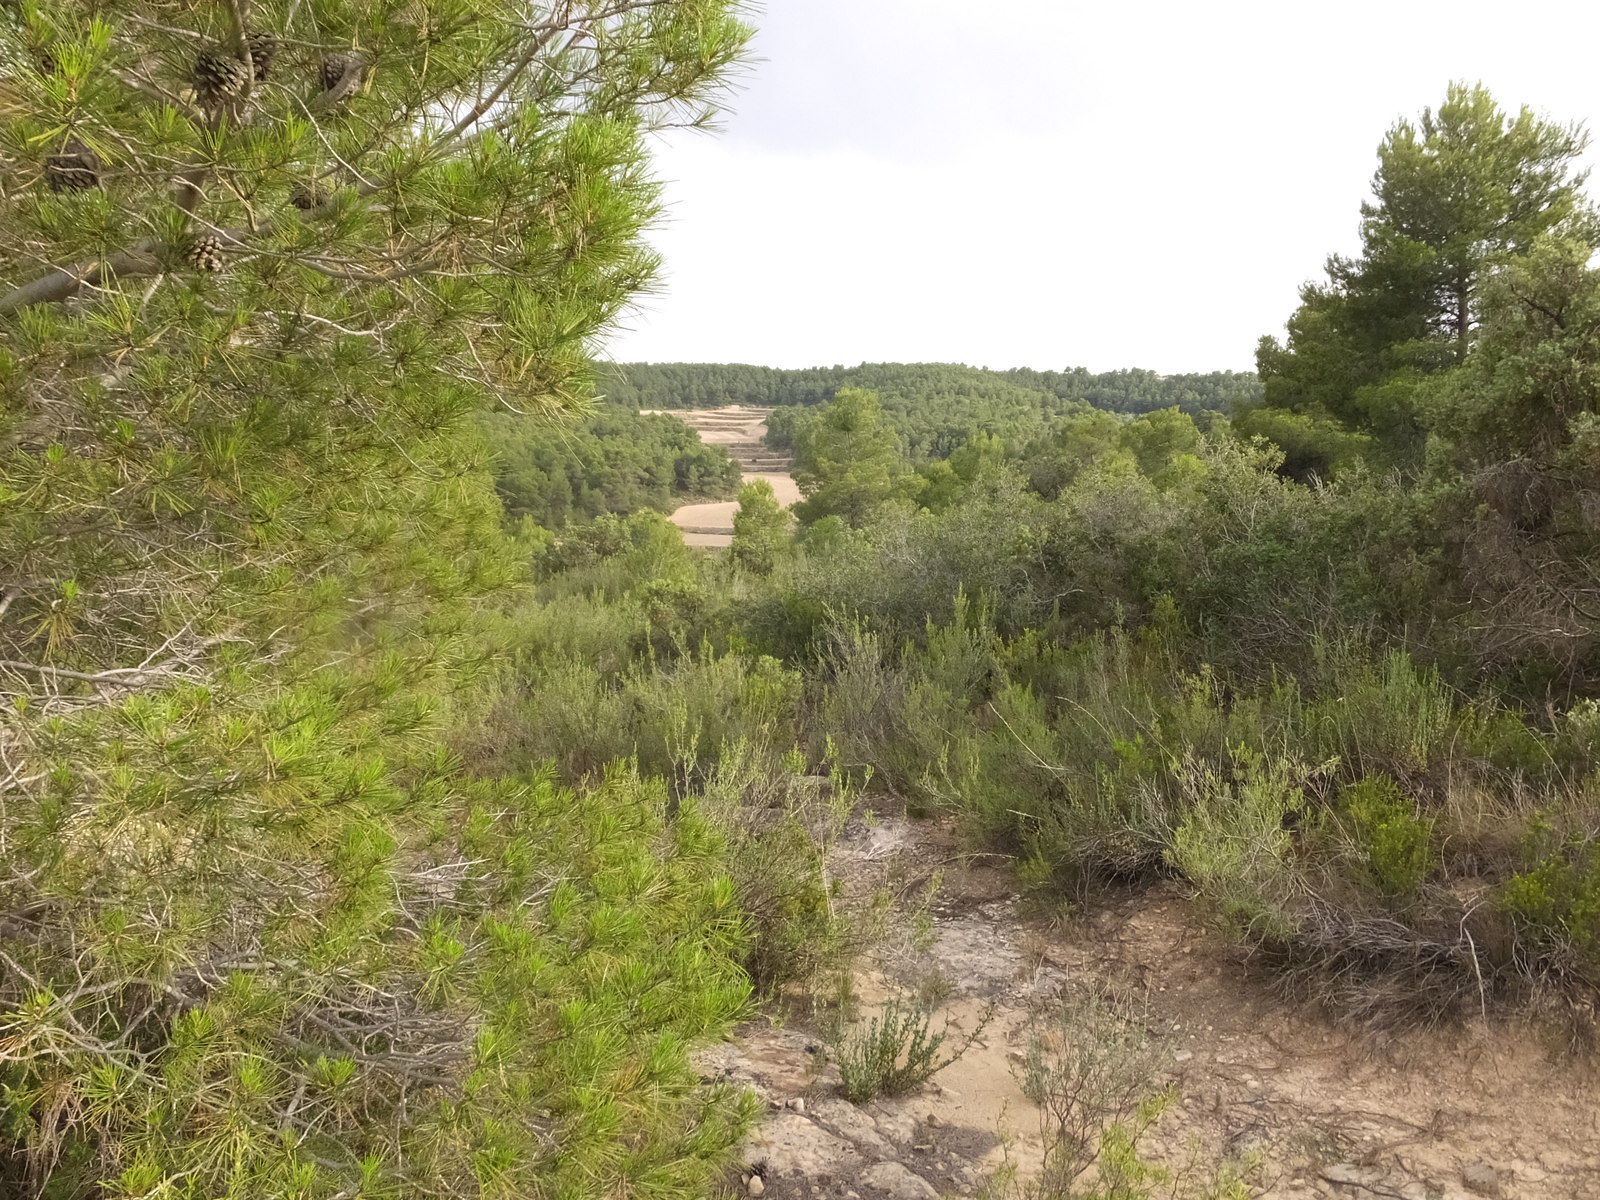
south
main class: Woodland
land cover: Pine dominated mixed woodland
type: coniferous forest of the mediterranean region
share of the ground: 50 - 75 %
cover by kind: coniferous forest trees 50 %, shrubs 30 %, broadleaved forest trees 20 %
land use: Forestry
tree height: < 5 m
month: July
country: ES
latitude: 41.3330
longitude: 0.4900
